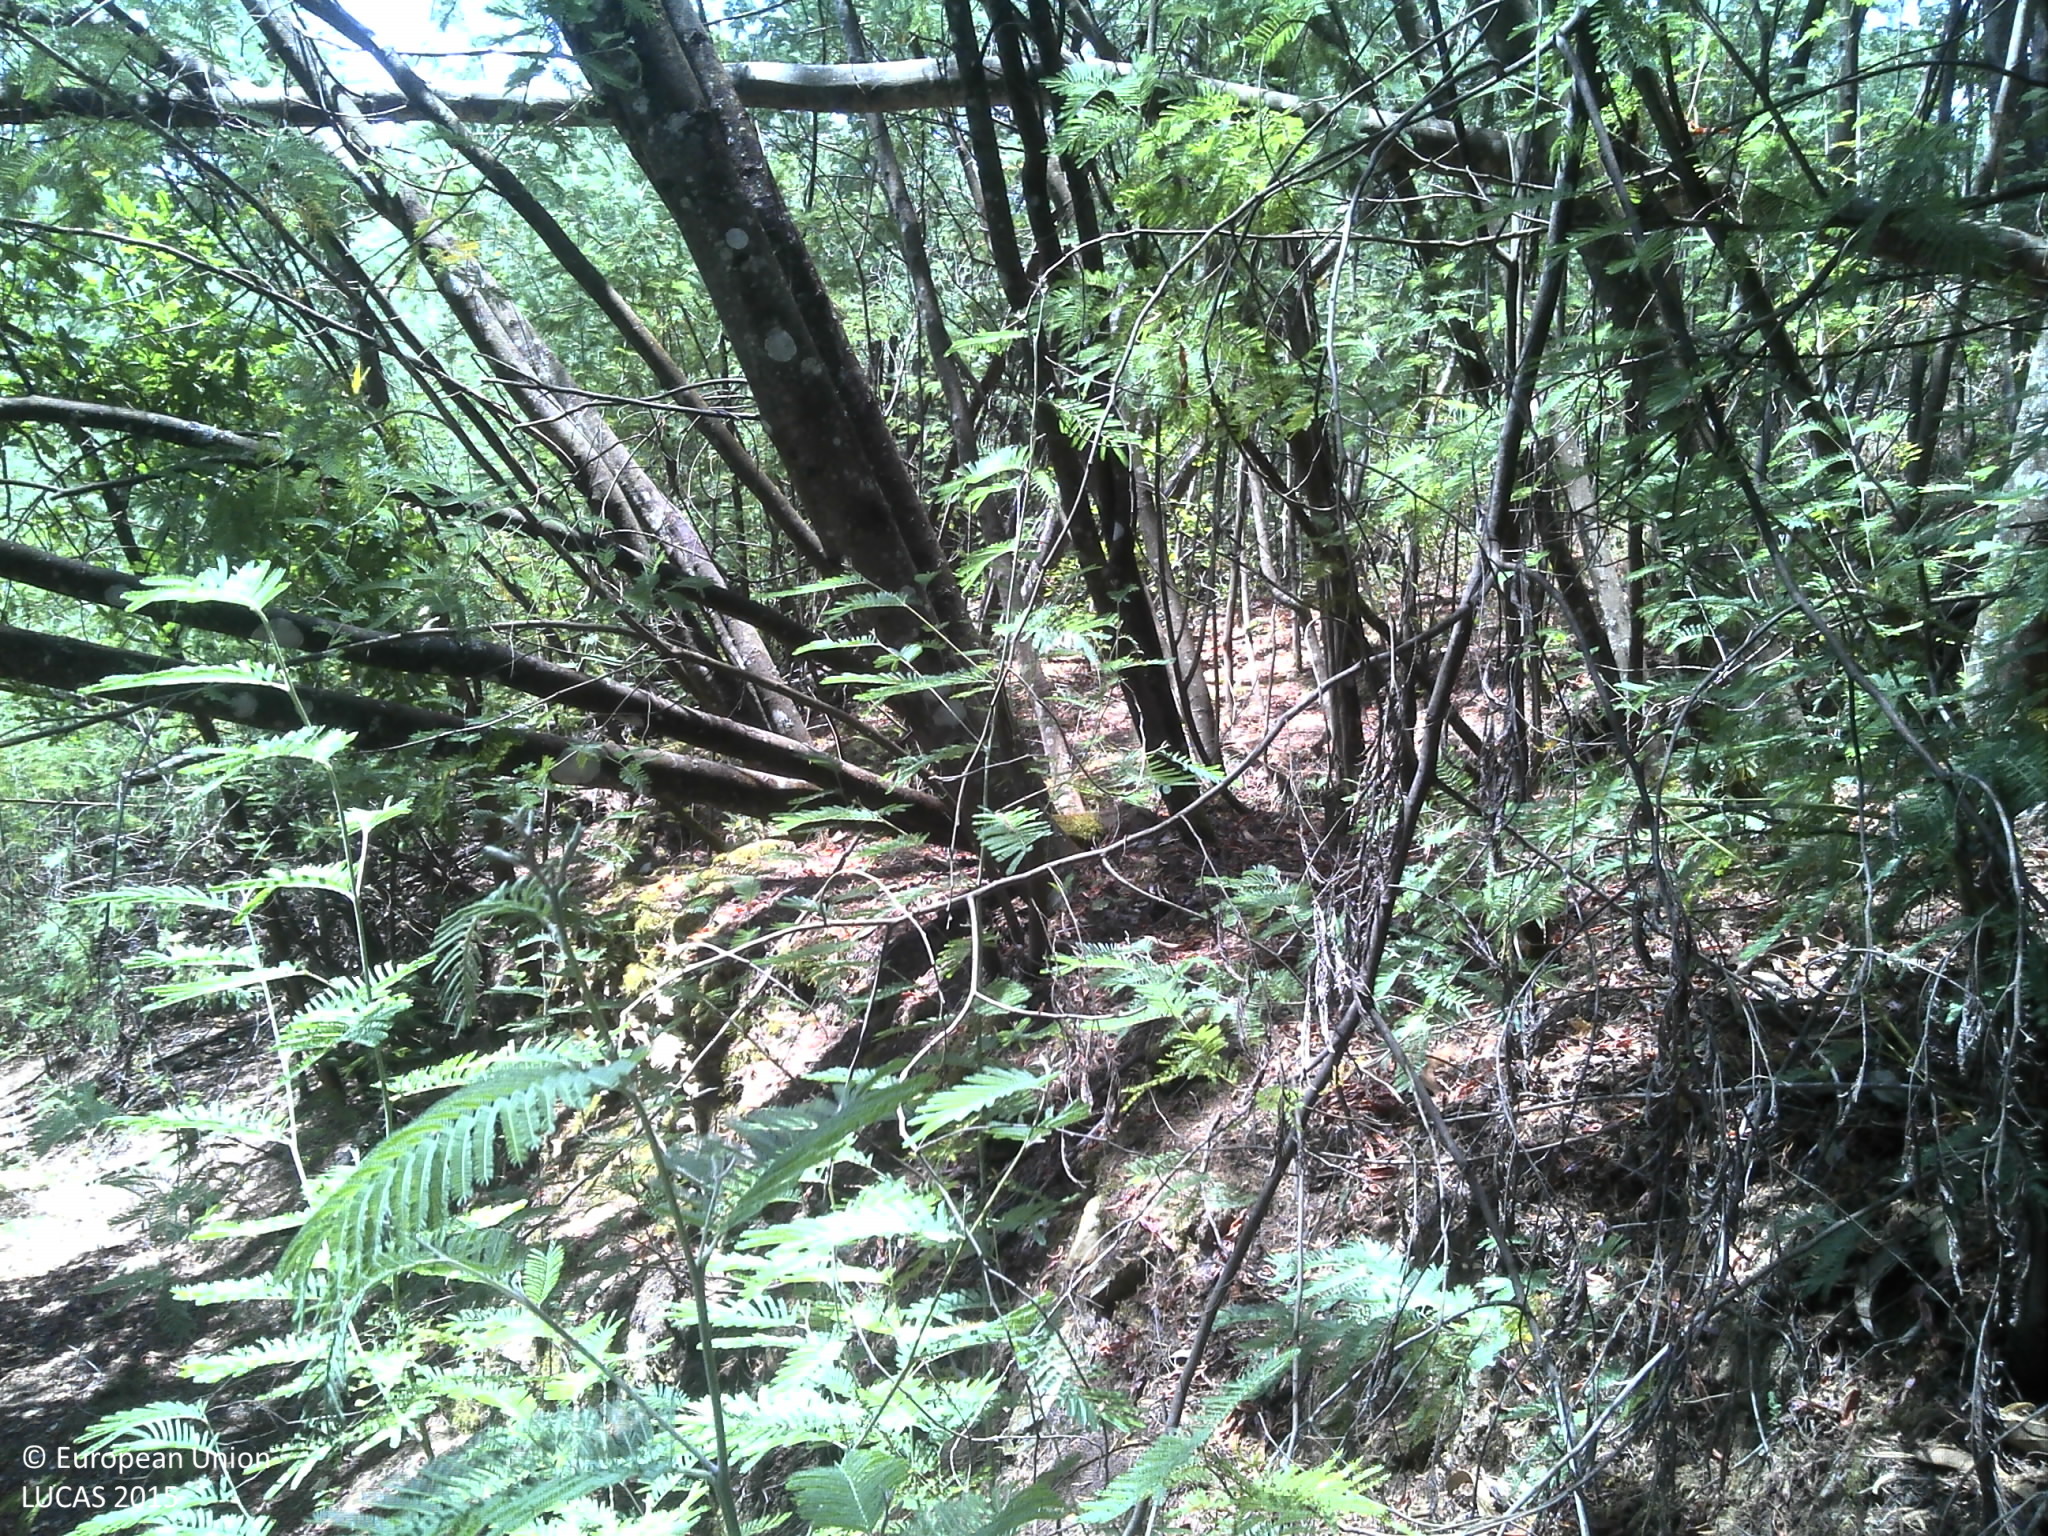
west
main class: Woodland
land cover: Broadleaved woodland
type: exotic forest
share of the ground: > 75 %
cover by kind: broadleaved forest trees 80 %, unconsolidated bare surface 15 %, shrubs 5 %
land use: Semi-natural and natural areas not in use
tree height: > 5 m
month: July
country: PT
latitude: 40.2376
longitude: -8.2631
